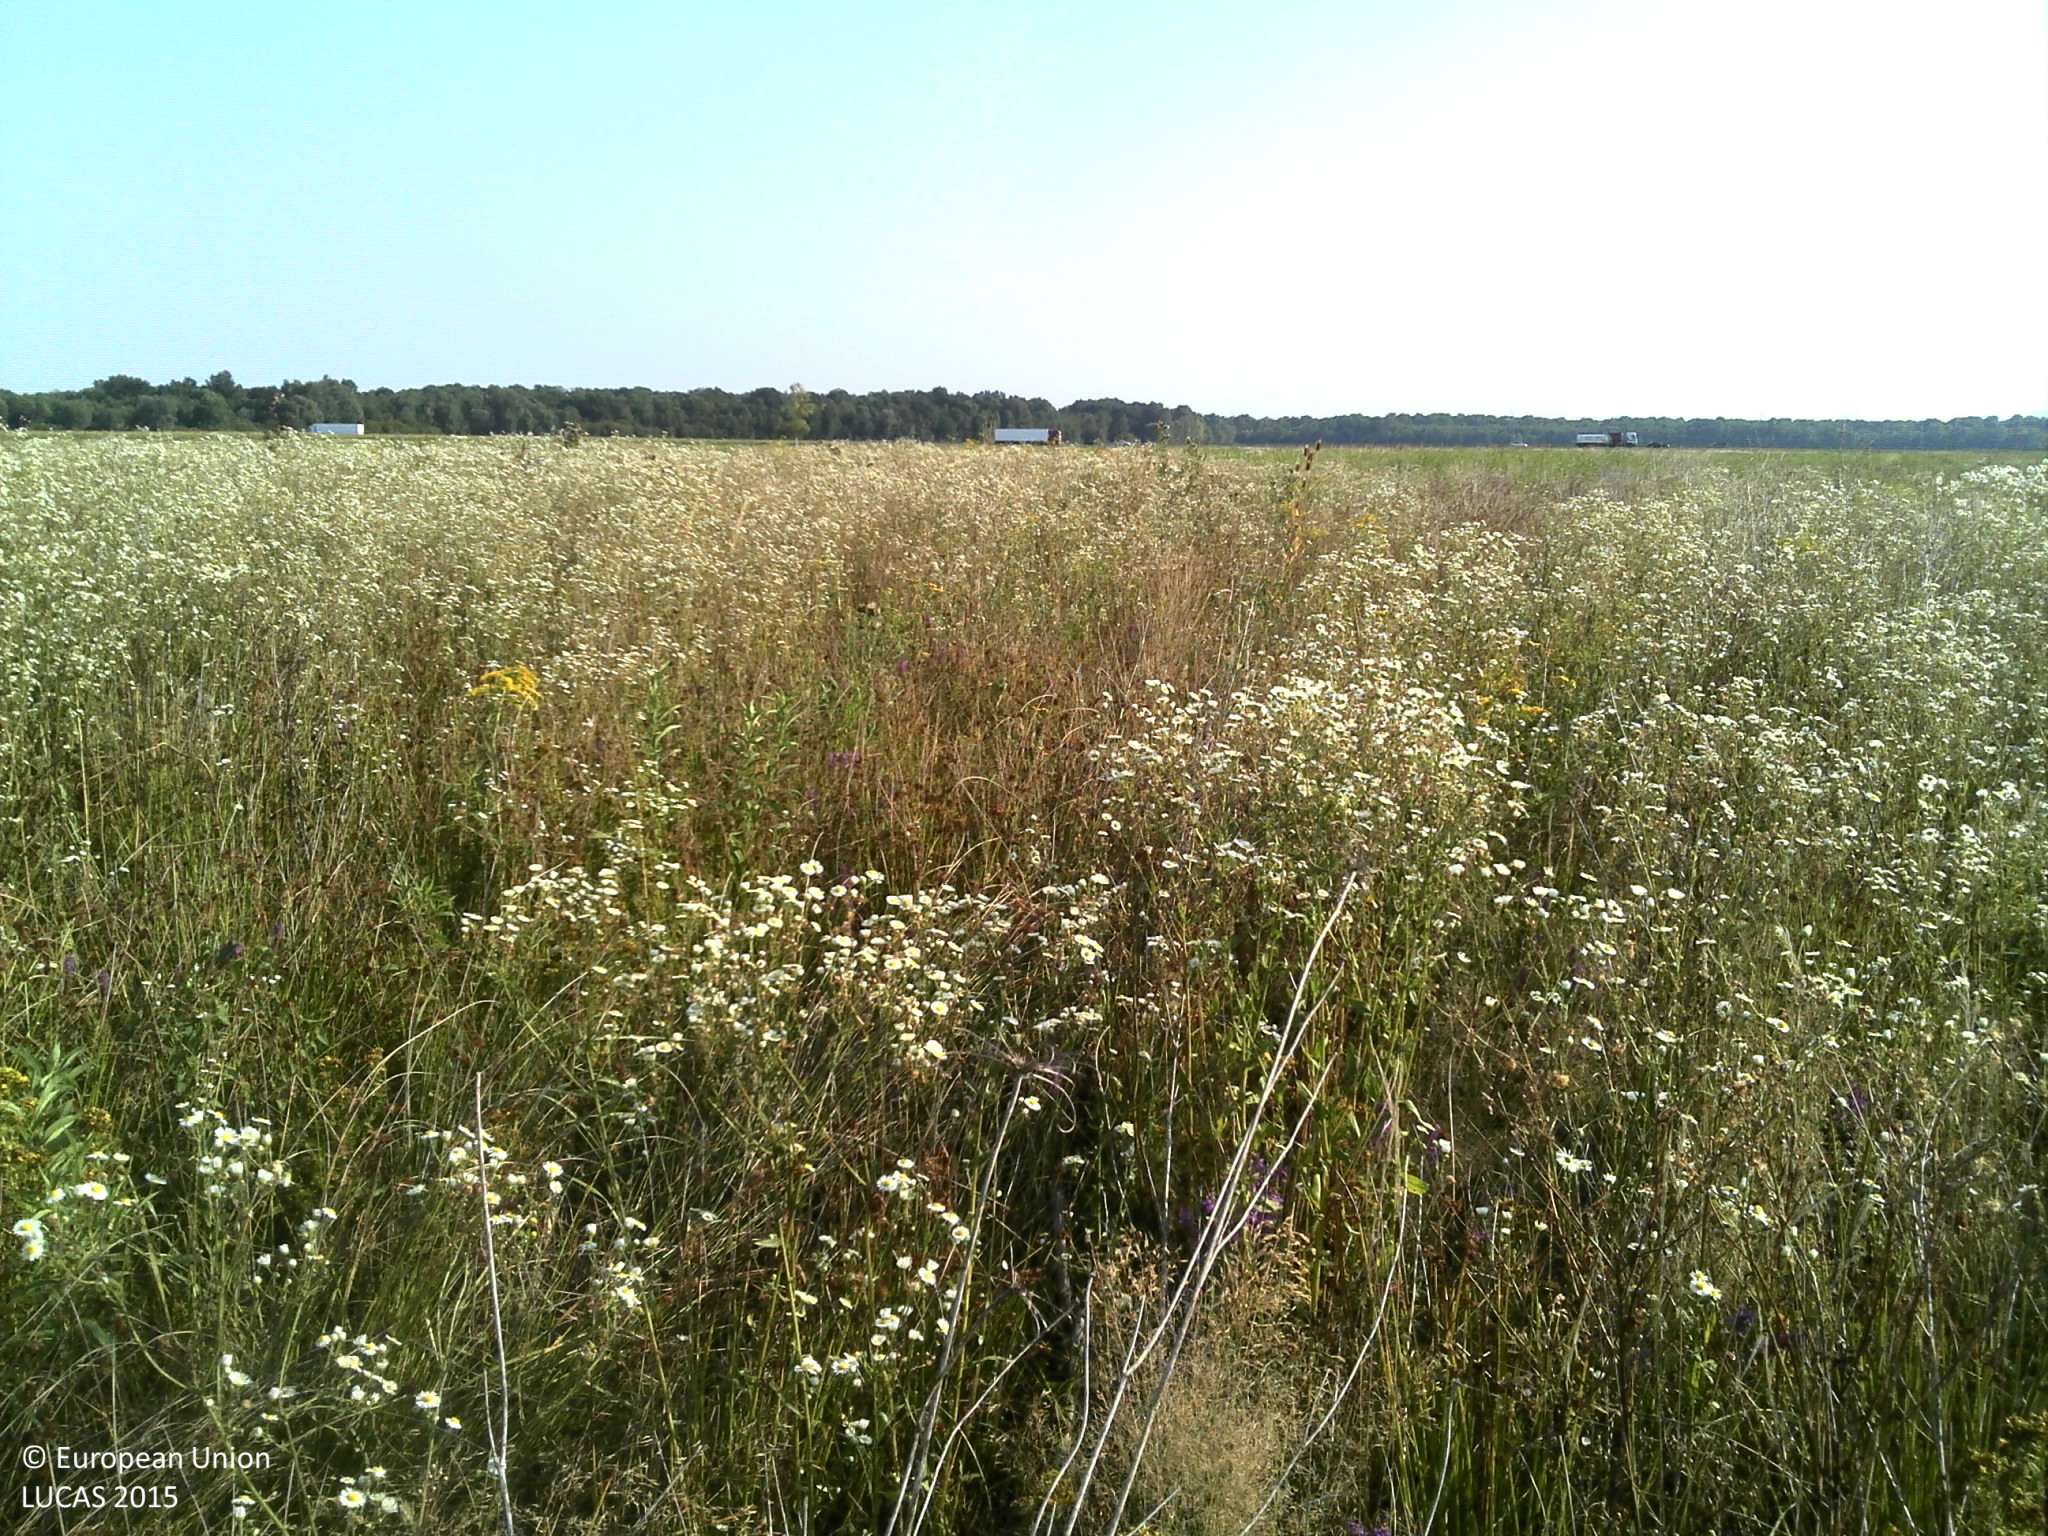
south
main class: Grassland
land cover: Spontaneously vegetated surfaces
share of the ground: > 75 %
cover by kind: herbaceous plants 100 %
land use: Fallow land
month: August
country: HR
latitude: 45.6862
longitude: 16.4572
